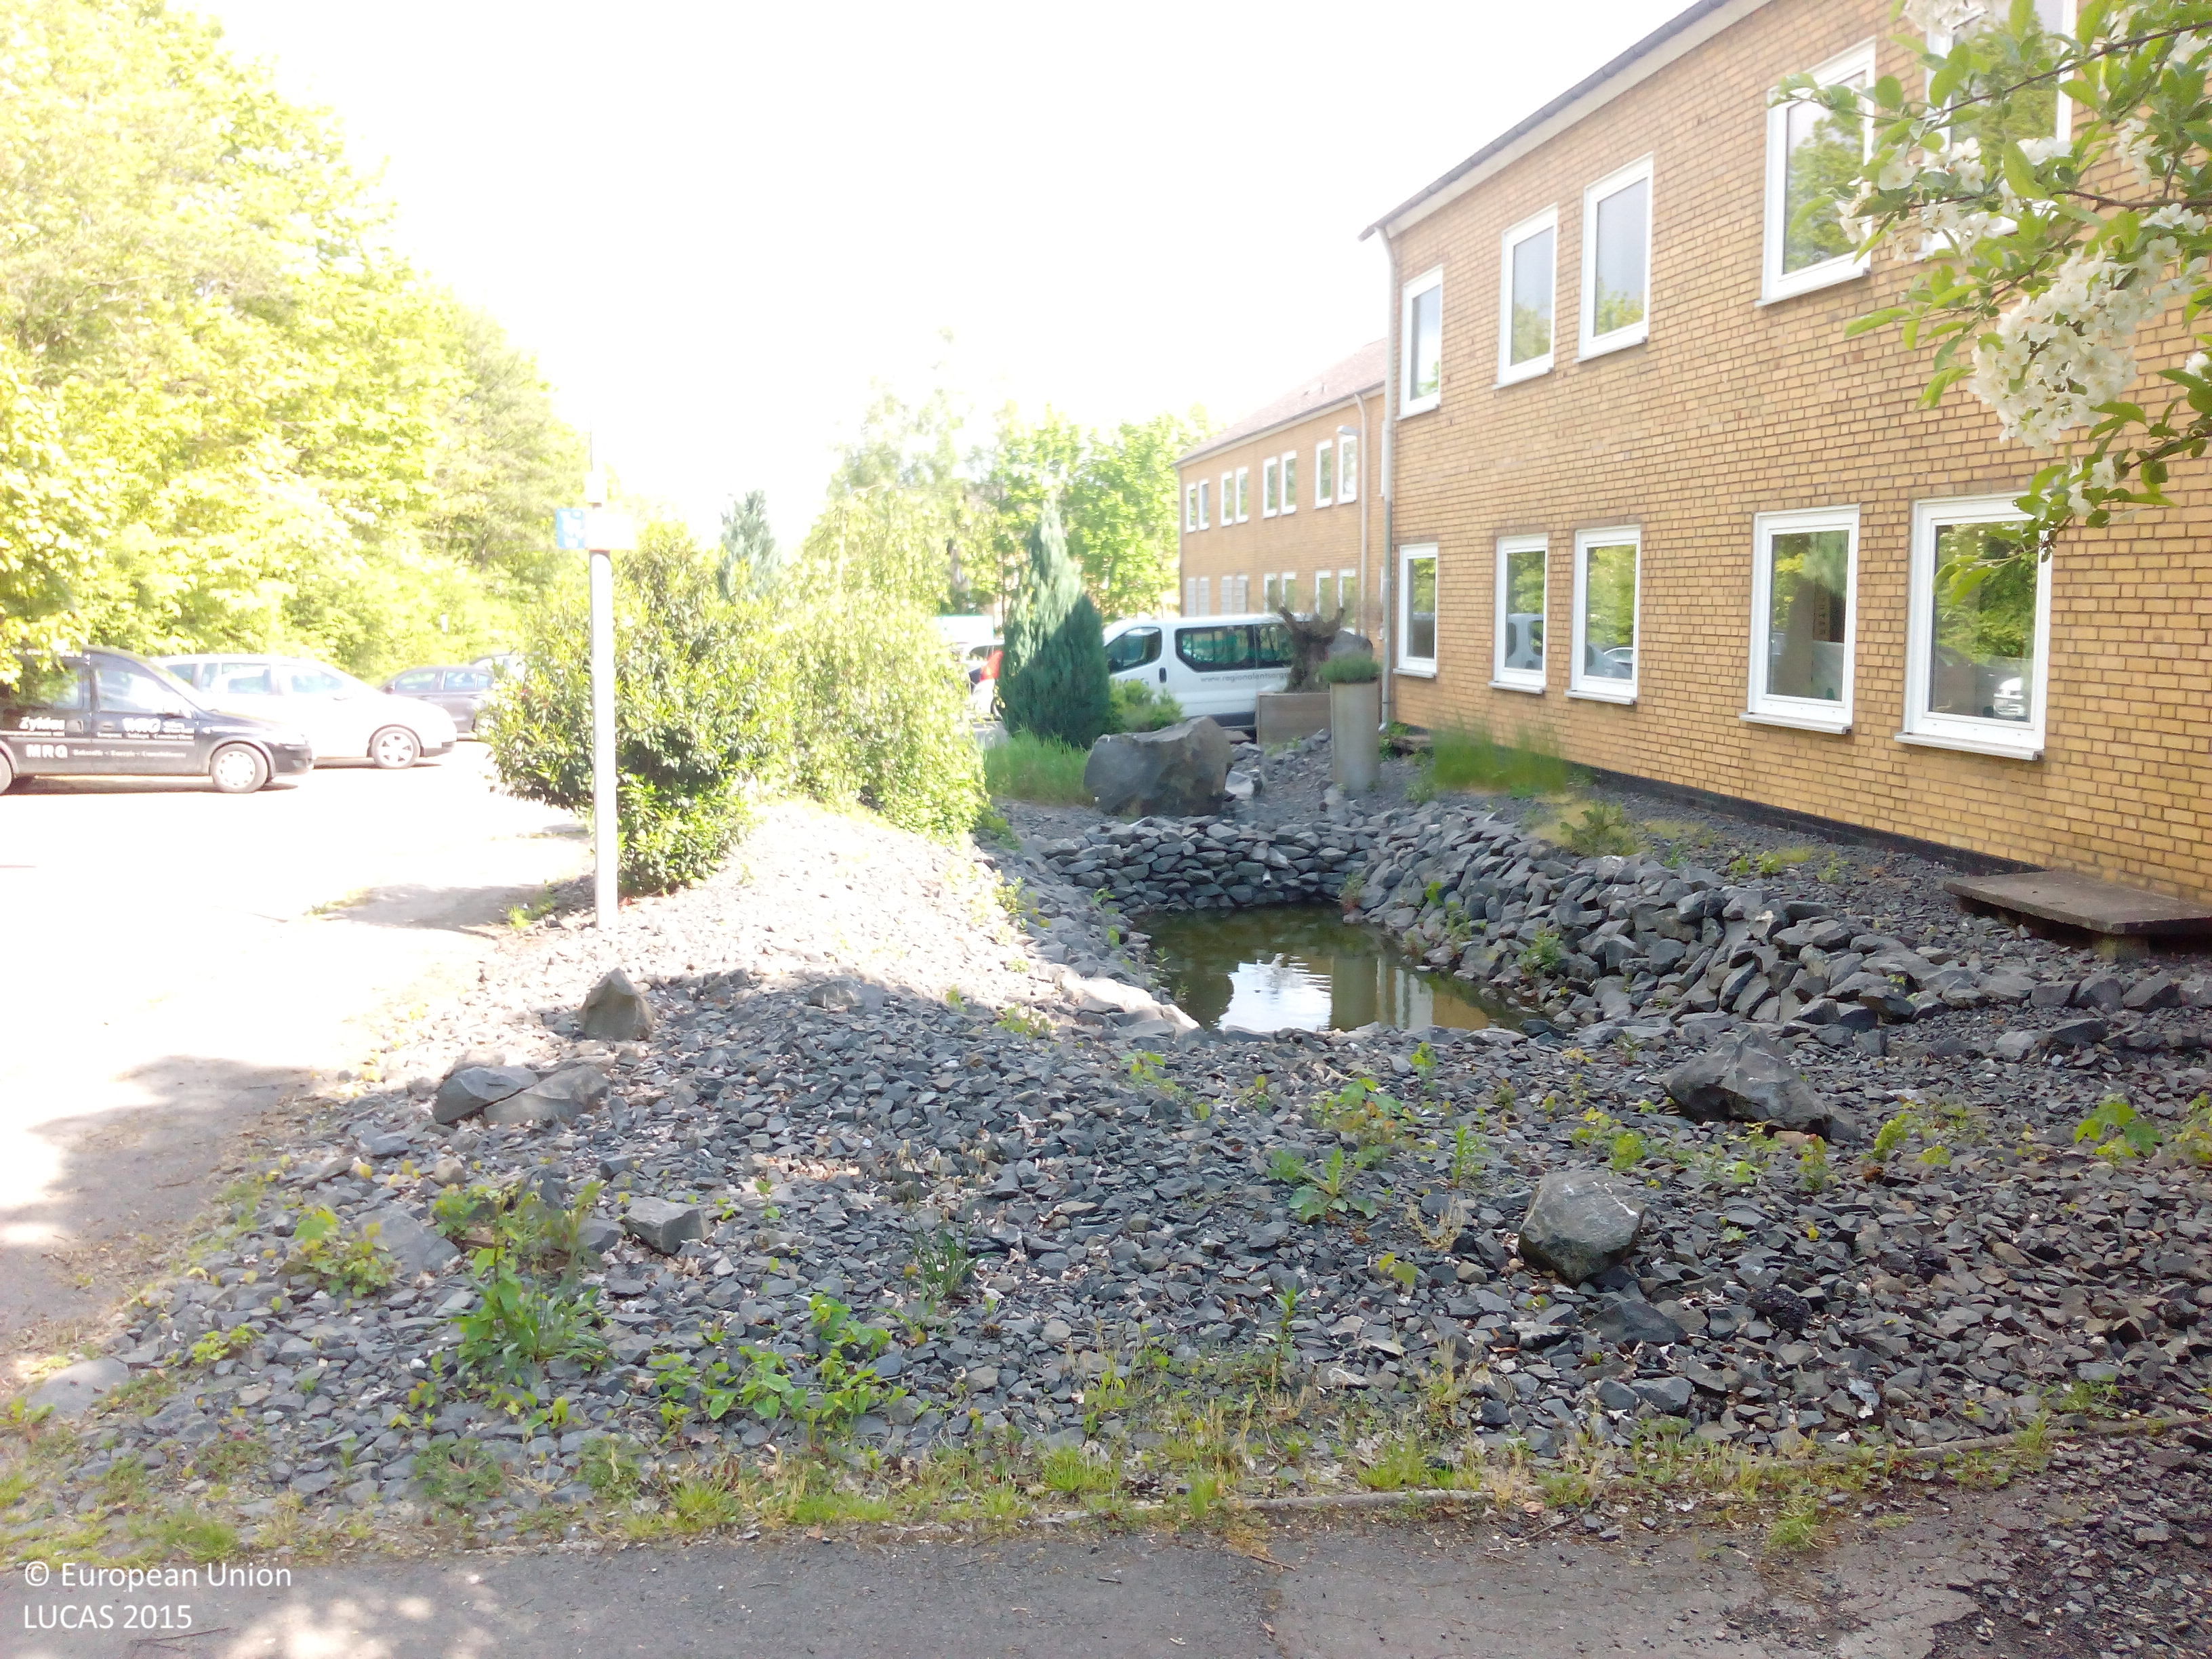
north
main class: Shrubland
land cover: Shrubland without tree cover
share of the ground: > 75 %
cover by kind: shrubs 100 %
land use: Road transport
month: May
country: DE
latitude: 51.8736
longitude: 9.6370
